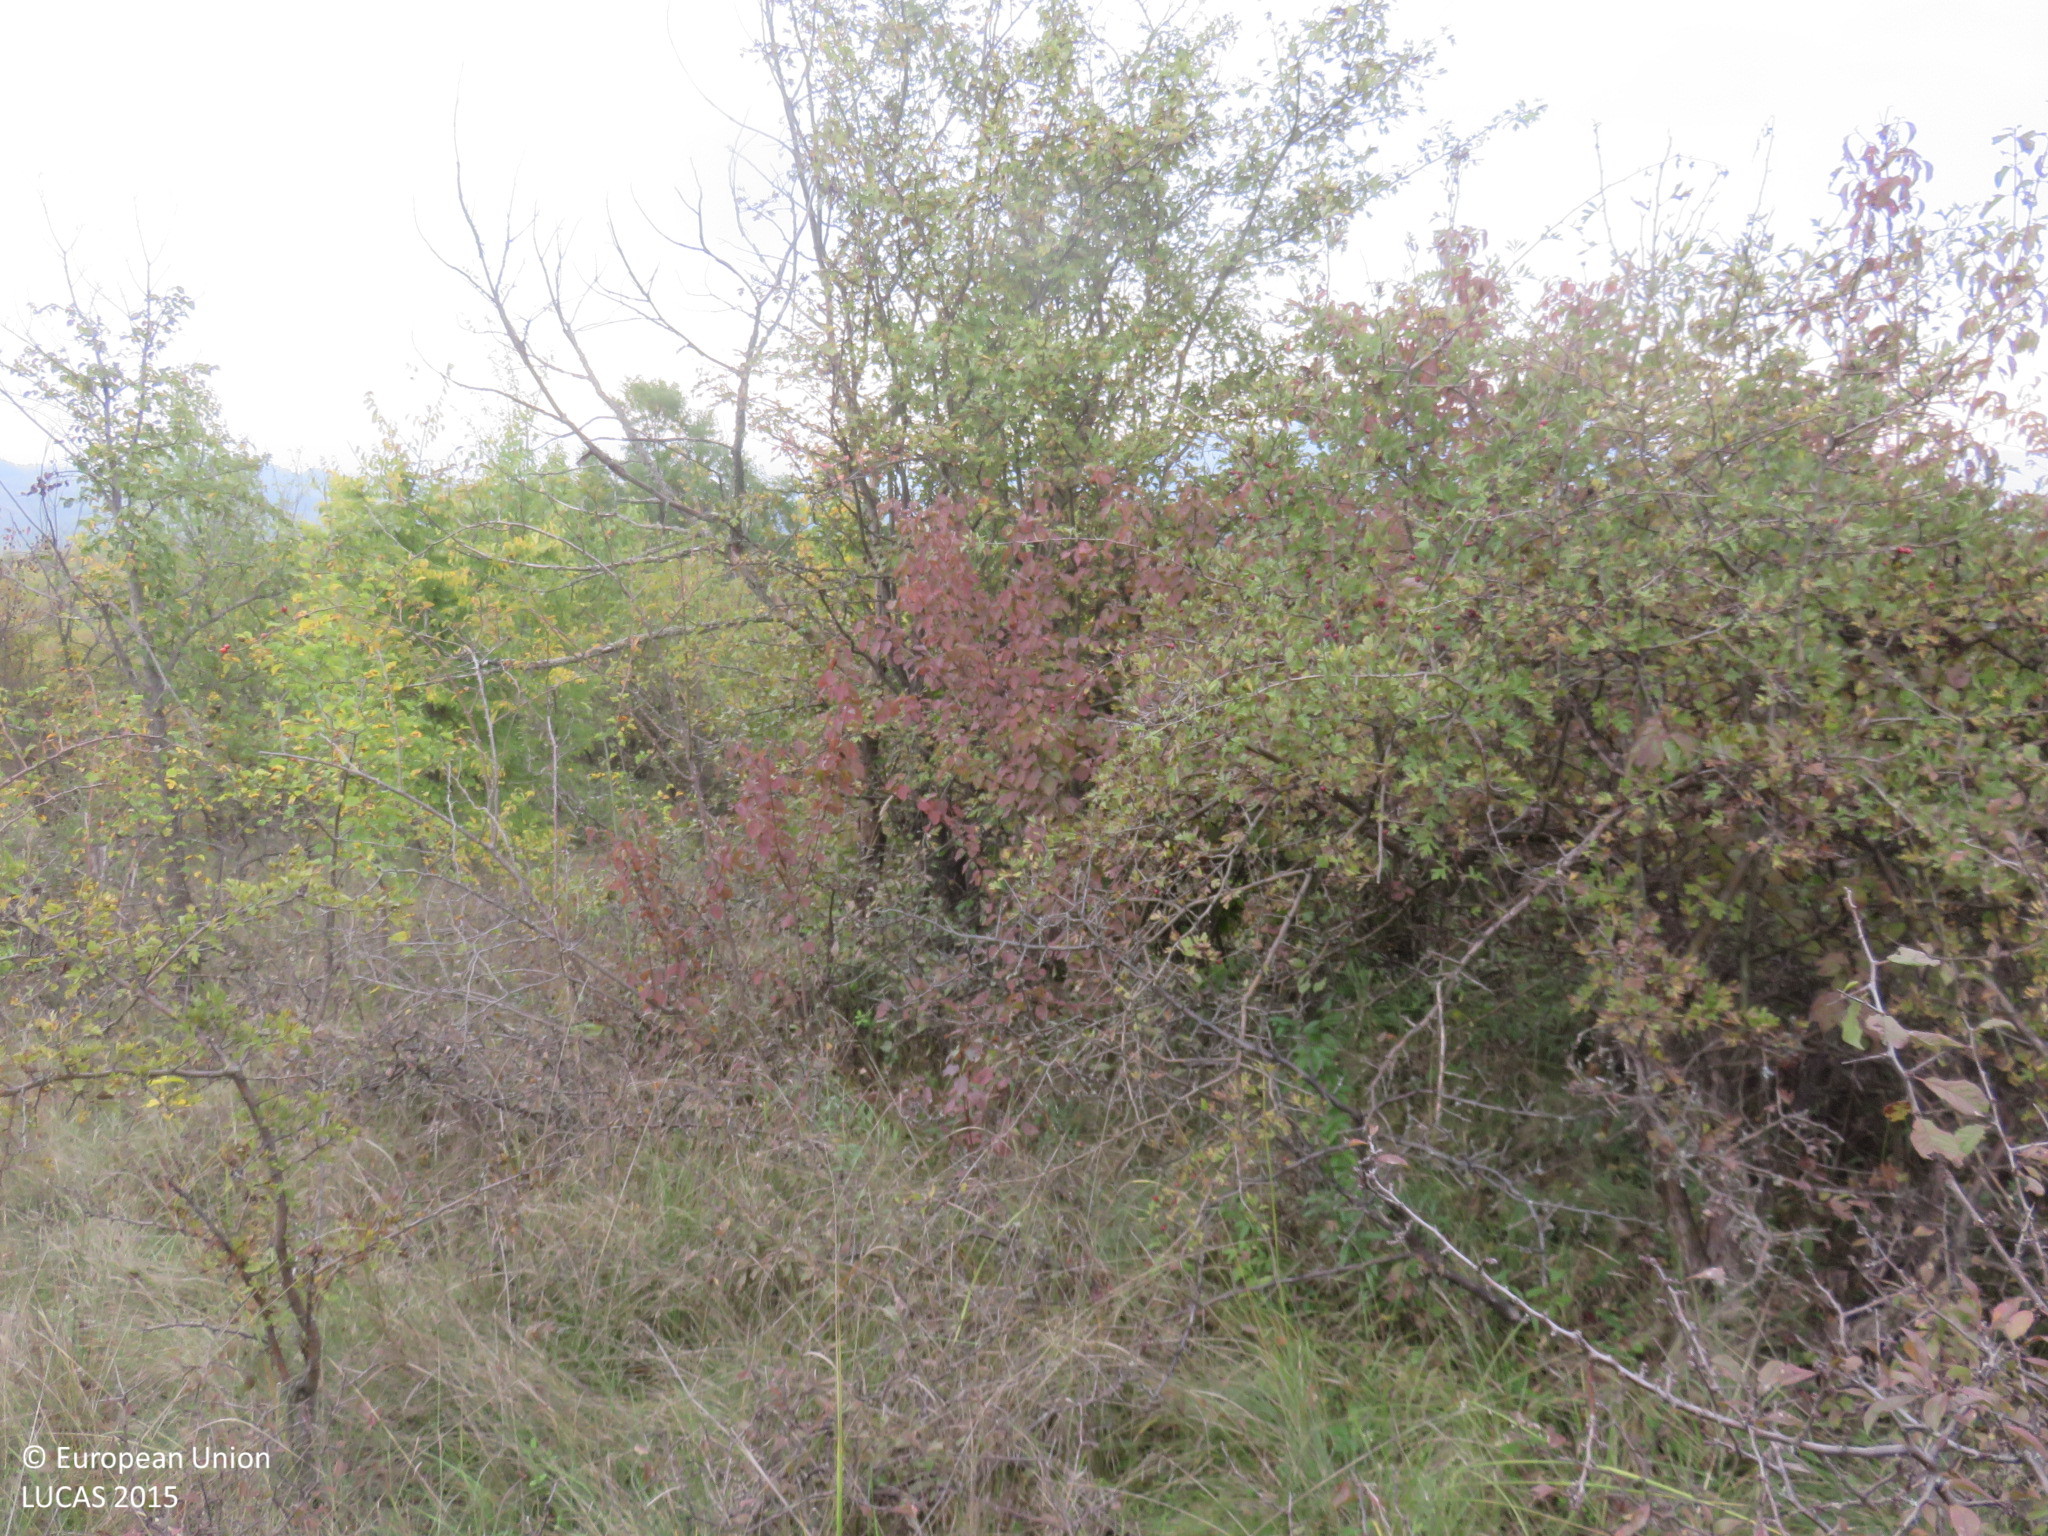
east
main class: Woodland
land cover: Broadleaved woodland
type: mesophytic deciduous forest
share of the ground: 10 - 25 %
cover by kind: shrubs 40 %, herbaceous plants 40 %, broadleaved forest trees 15 %, coniferous forest trees 5 %
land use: Semi-natural and natural areas not in use
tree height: < 5 m
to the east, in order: Broadleaved woodland; Other fruit trees and berries
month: October
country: BG
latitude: 42.9933
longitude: 25.1428
